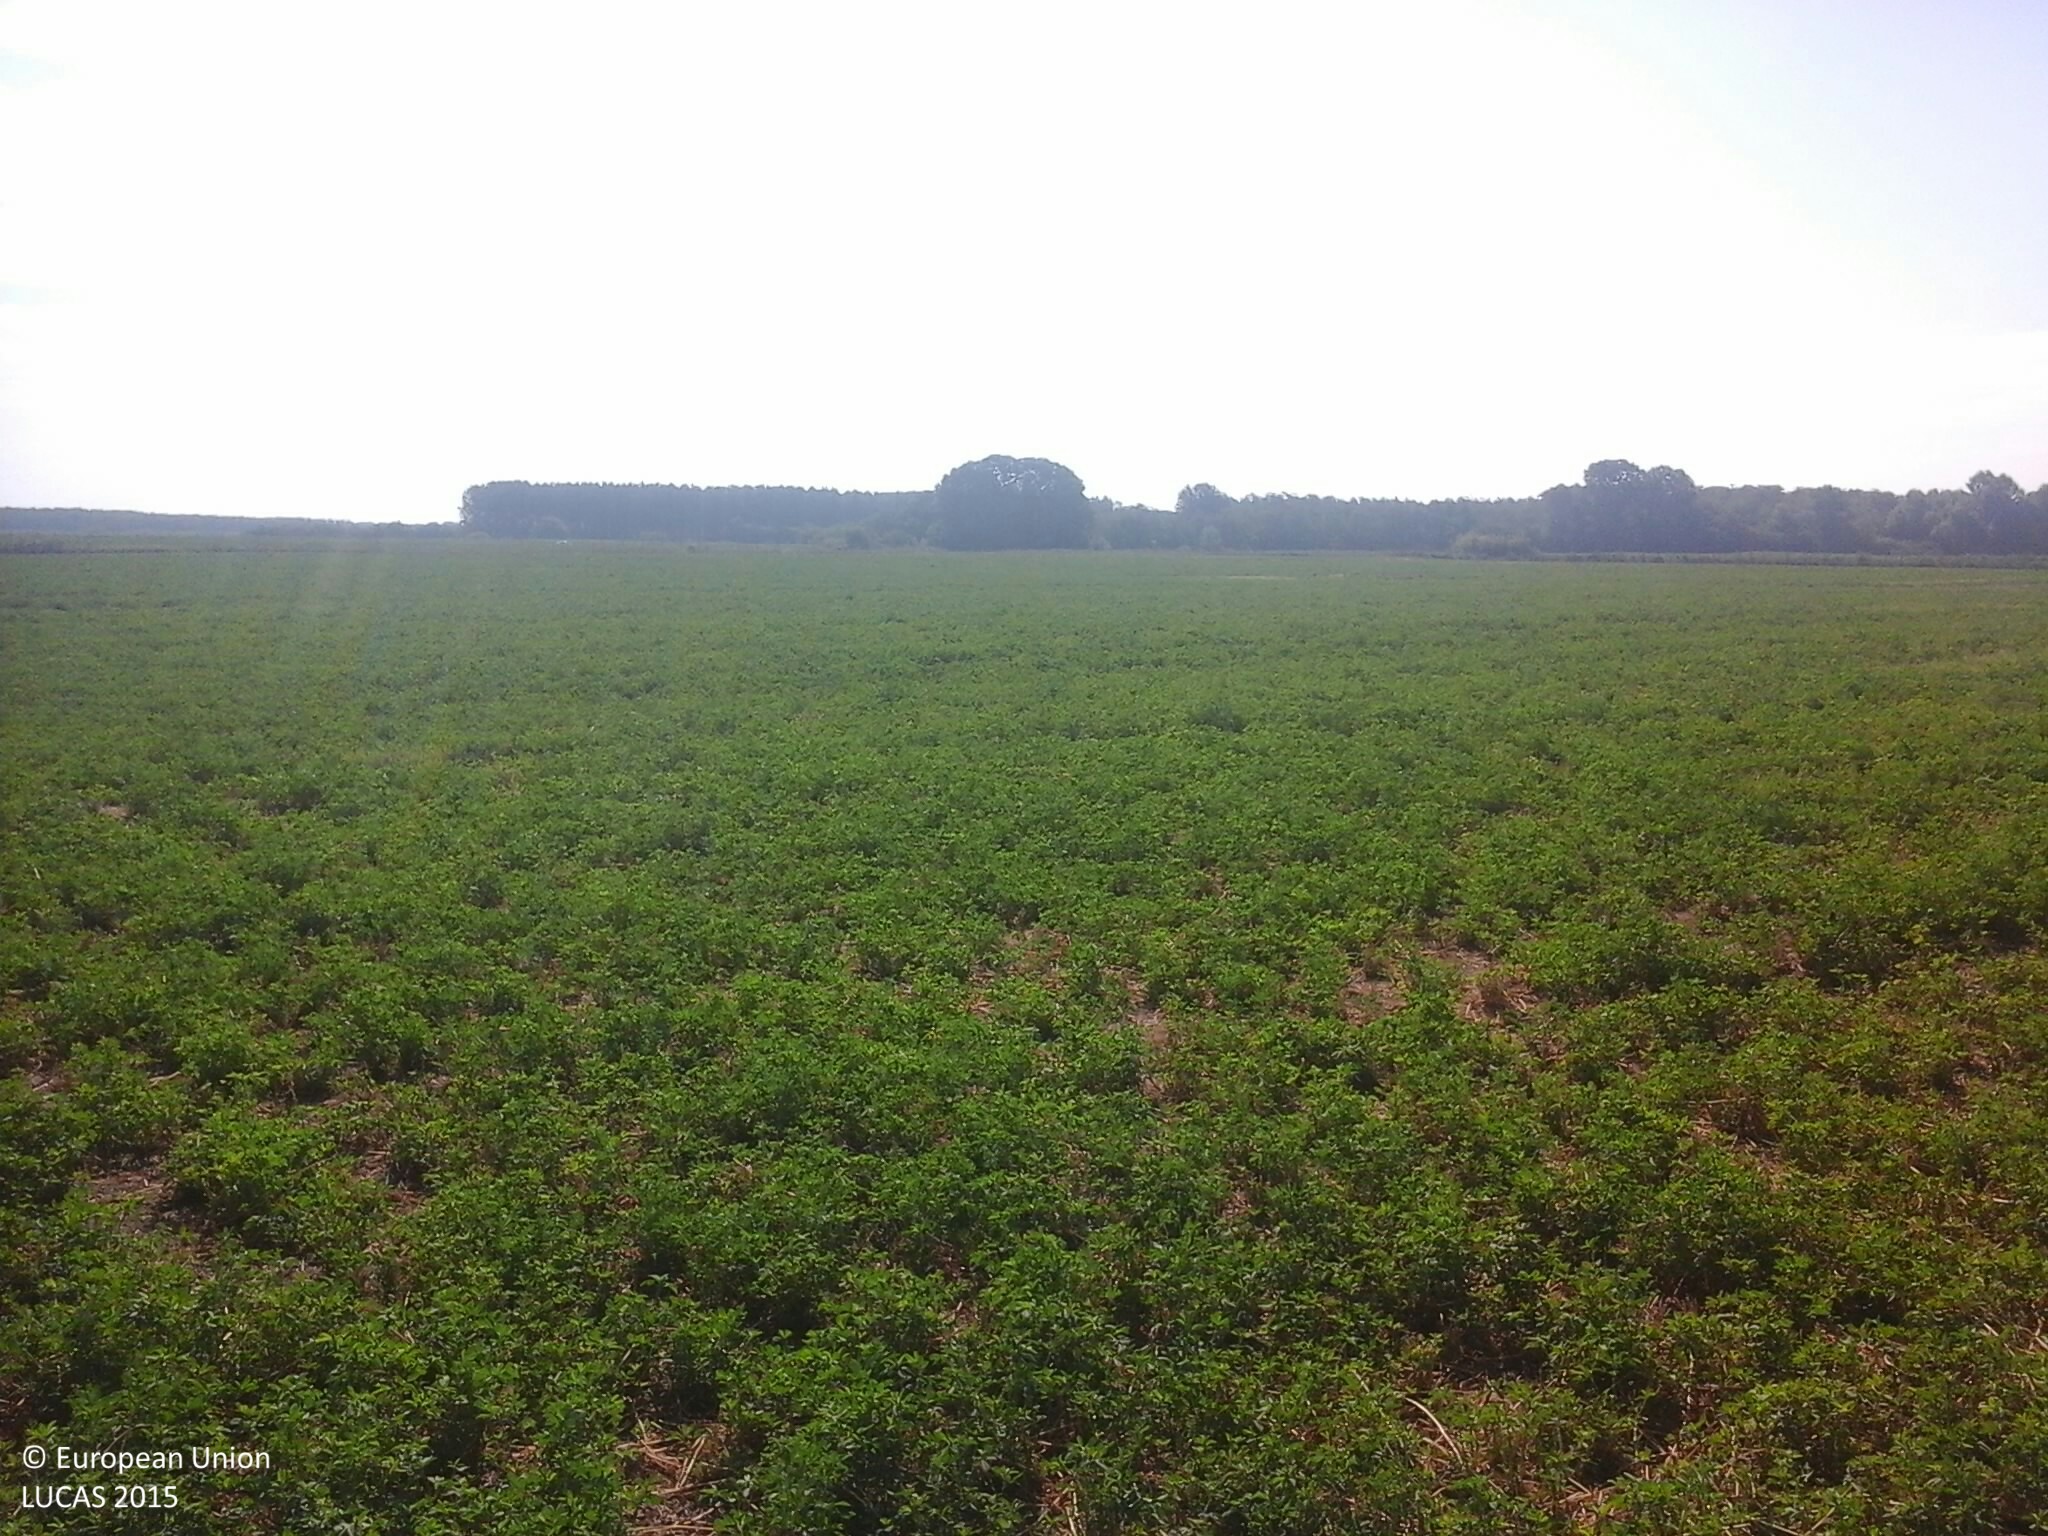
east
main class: Cropland
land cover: Lucerne
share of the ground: > 75 %
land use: Agriculture (excluding fallow land and kitchen gardens)
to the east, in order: Lucerne
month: July
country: HU
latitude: 47.8018
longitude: 22.1635
